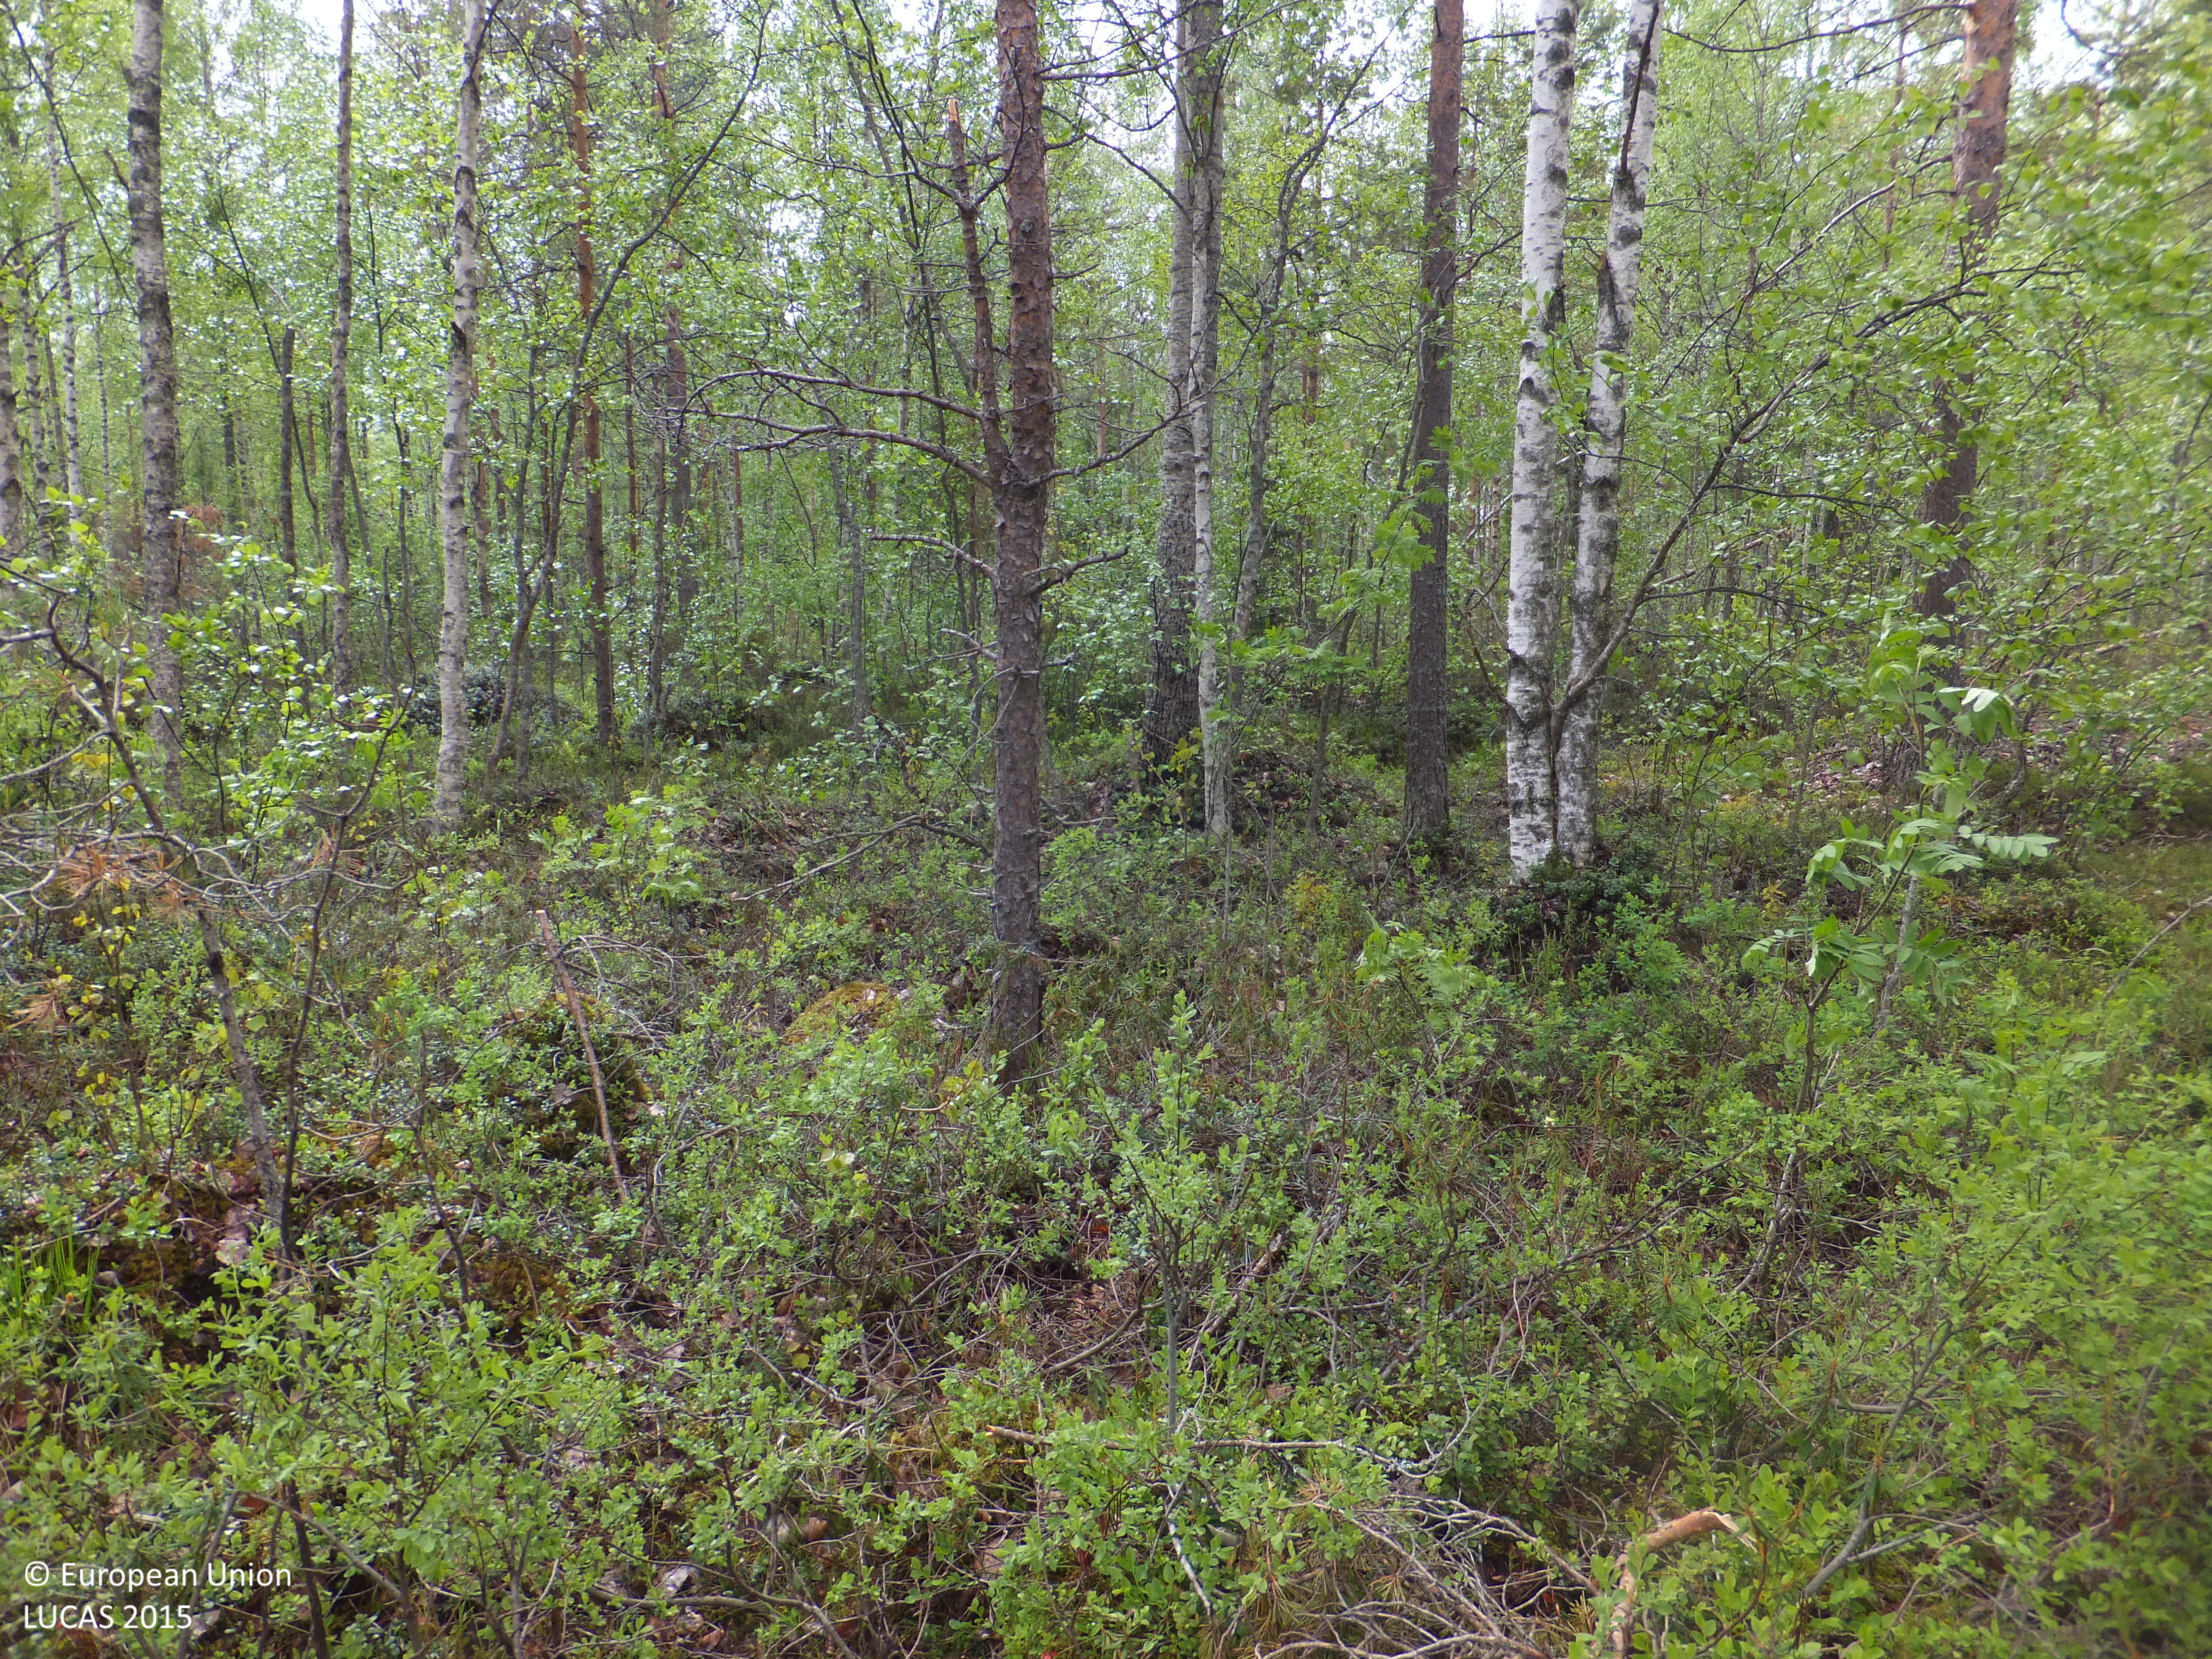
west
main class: Woodland
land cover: Pine dominated mixed woodland
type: boreal forest
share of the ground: 50 - 75 %
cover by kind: broadleaved forest trees 40 %, coniferous forest trees 30 %, shrubs 15 %, lichens and mosses 15 %
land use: Forestry
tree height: > 5 m
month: June
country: FI
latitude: 63.6149
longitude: 23.9240
